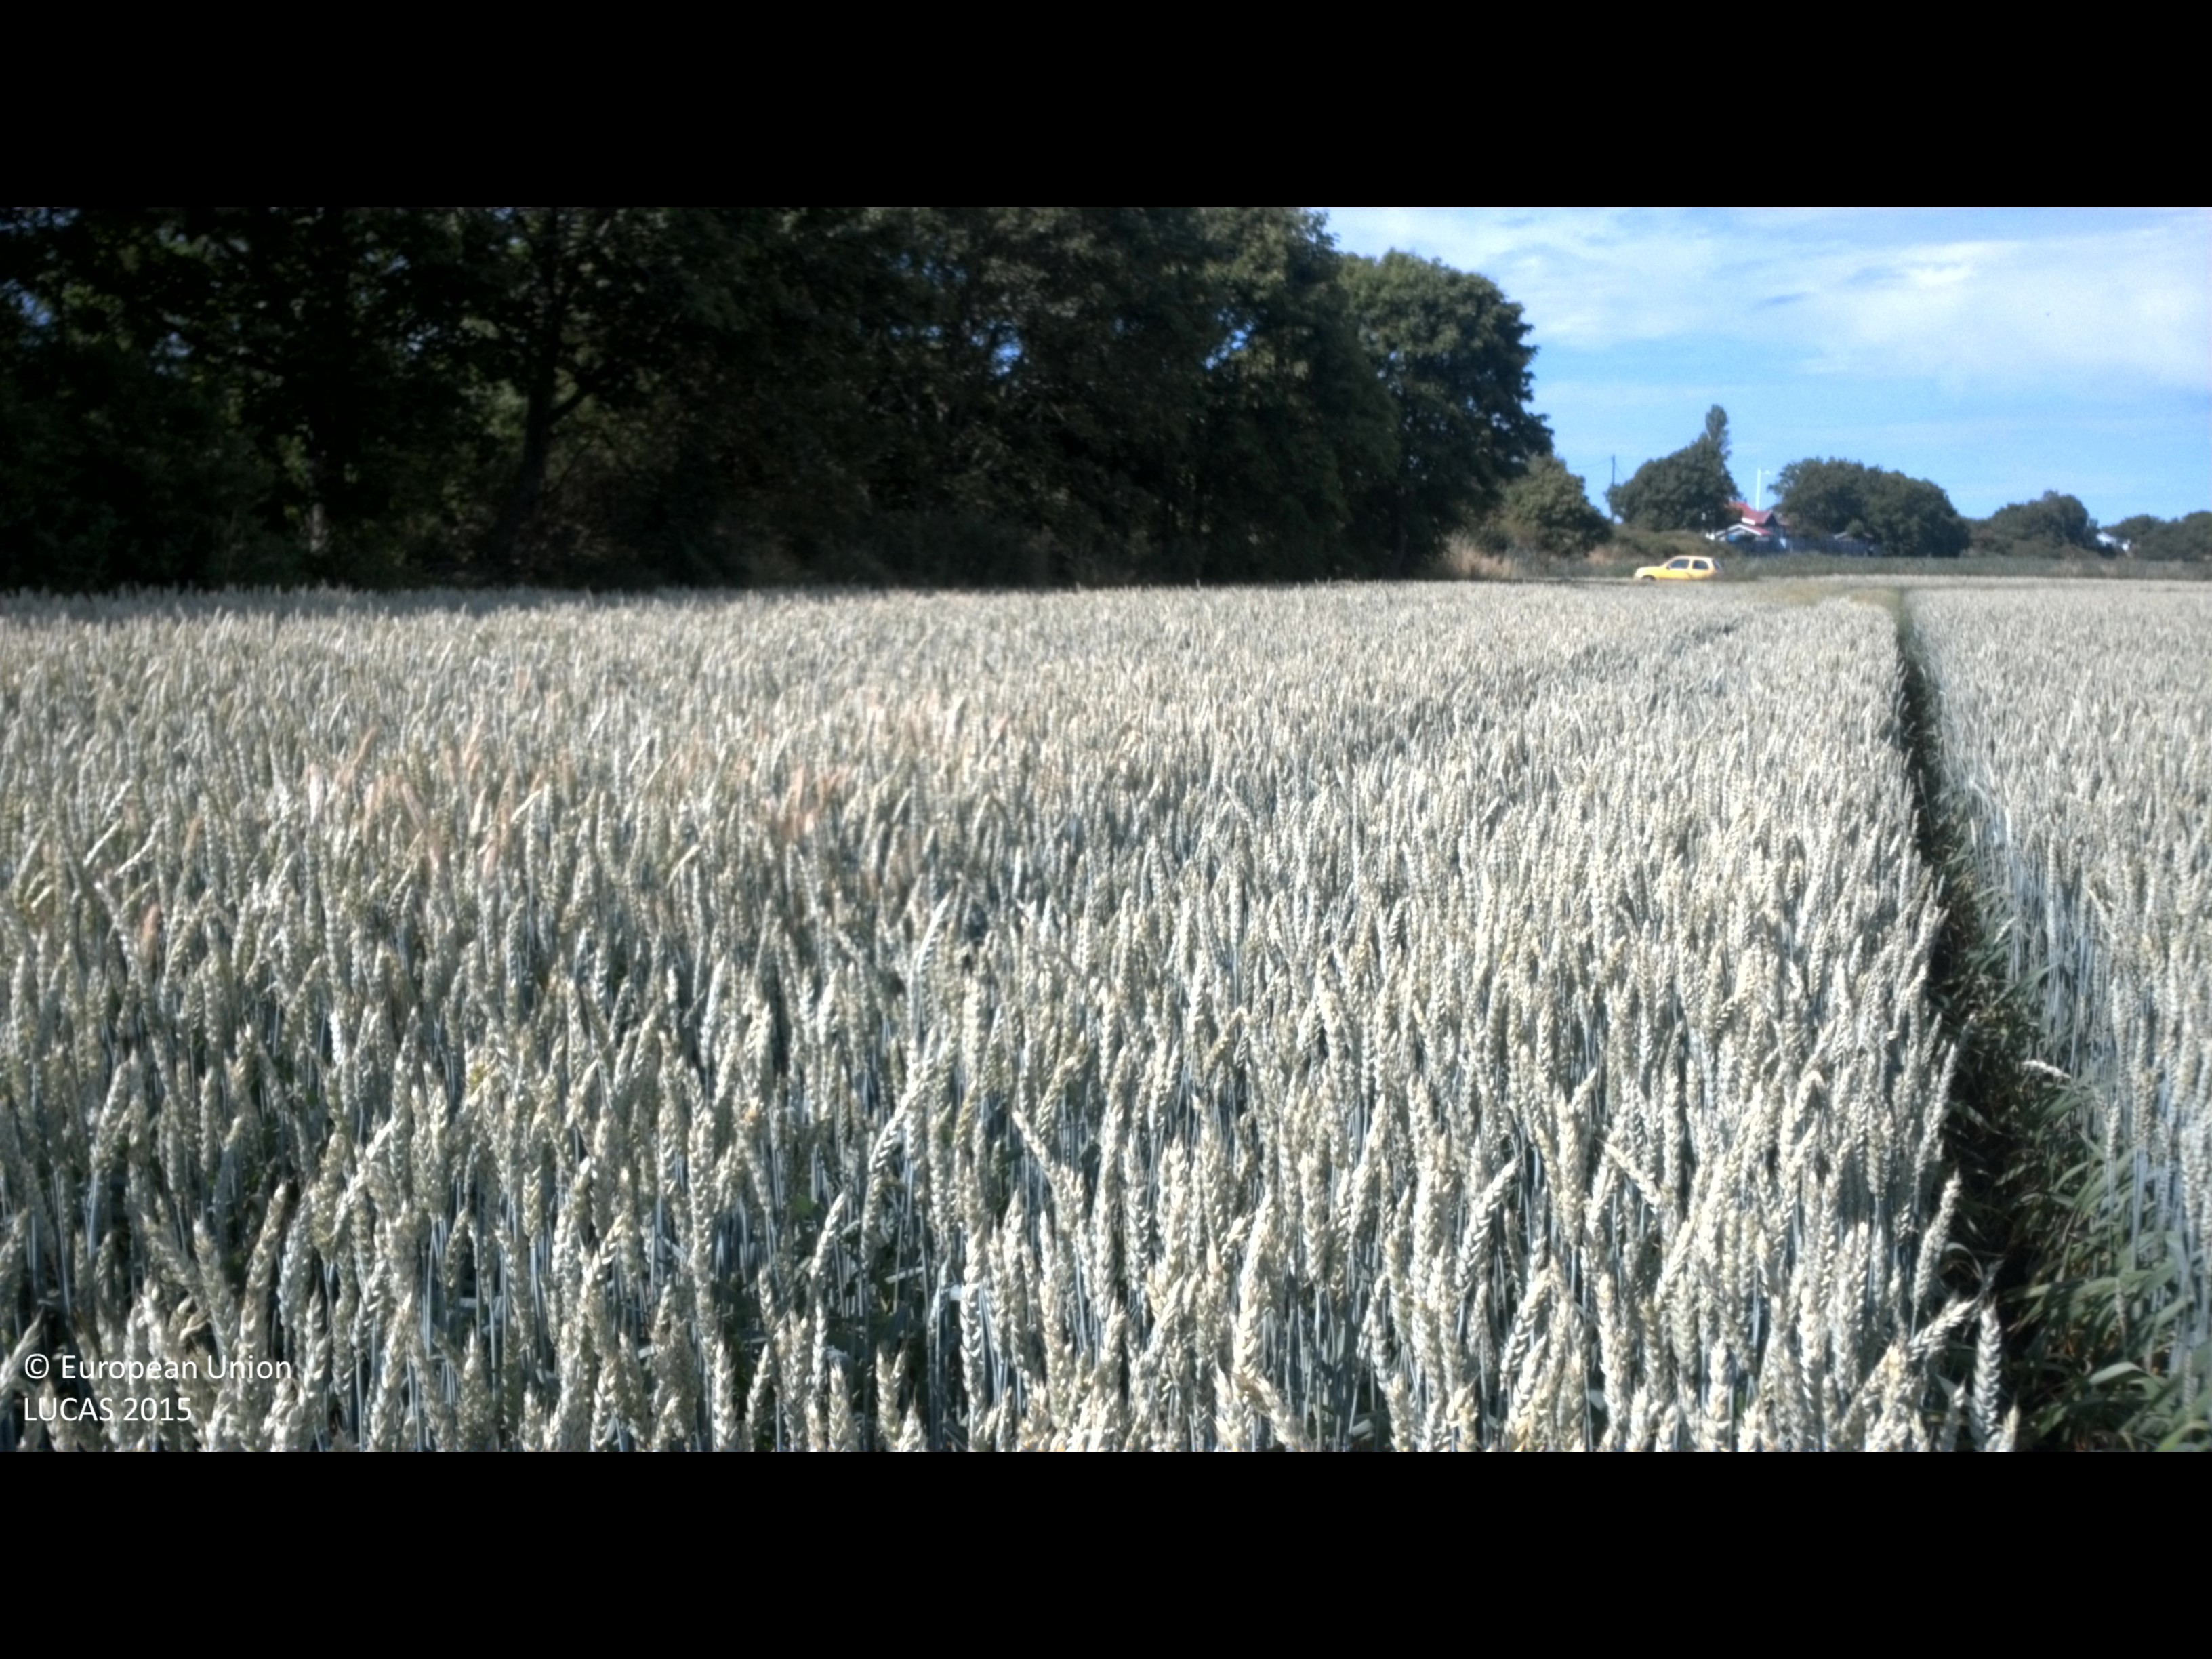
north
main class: Cropland
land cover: Common wheat
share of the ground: > 75 %
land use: Agriculture (excluding fallow land and kitchen gardens)
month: July
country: SE
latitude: 56.5841
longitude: 16.4652
